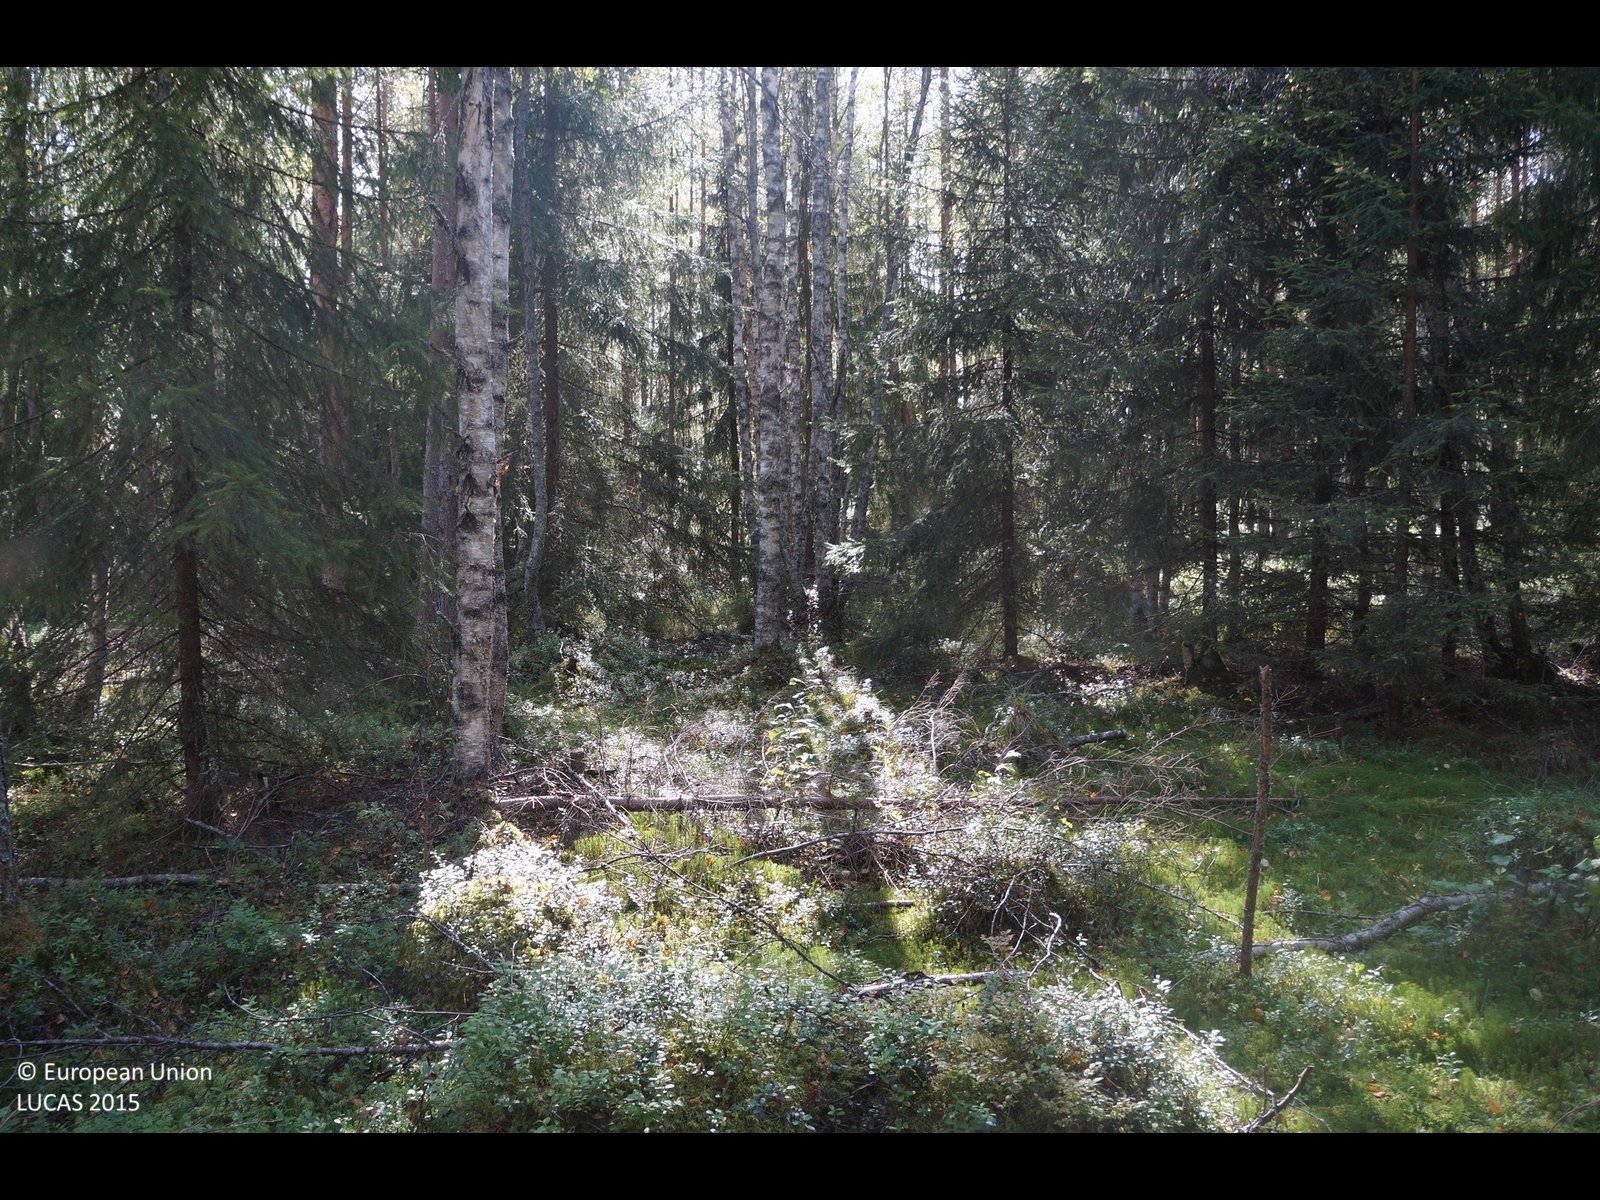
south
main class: Woodland
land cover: Pine dominated mixed woodland
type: boreal forest
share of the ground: 50 - 75 %
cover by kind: coniferous forest trees 50 %, broadleaved forest trees 20 %, shrubs 20 %, lichens and mosses 10 %
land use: Forestry
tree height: > 5 m
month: September
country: FI
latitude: 63.8967
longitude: 24.0623
